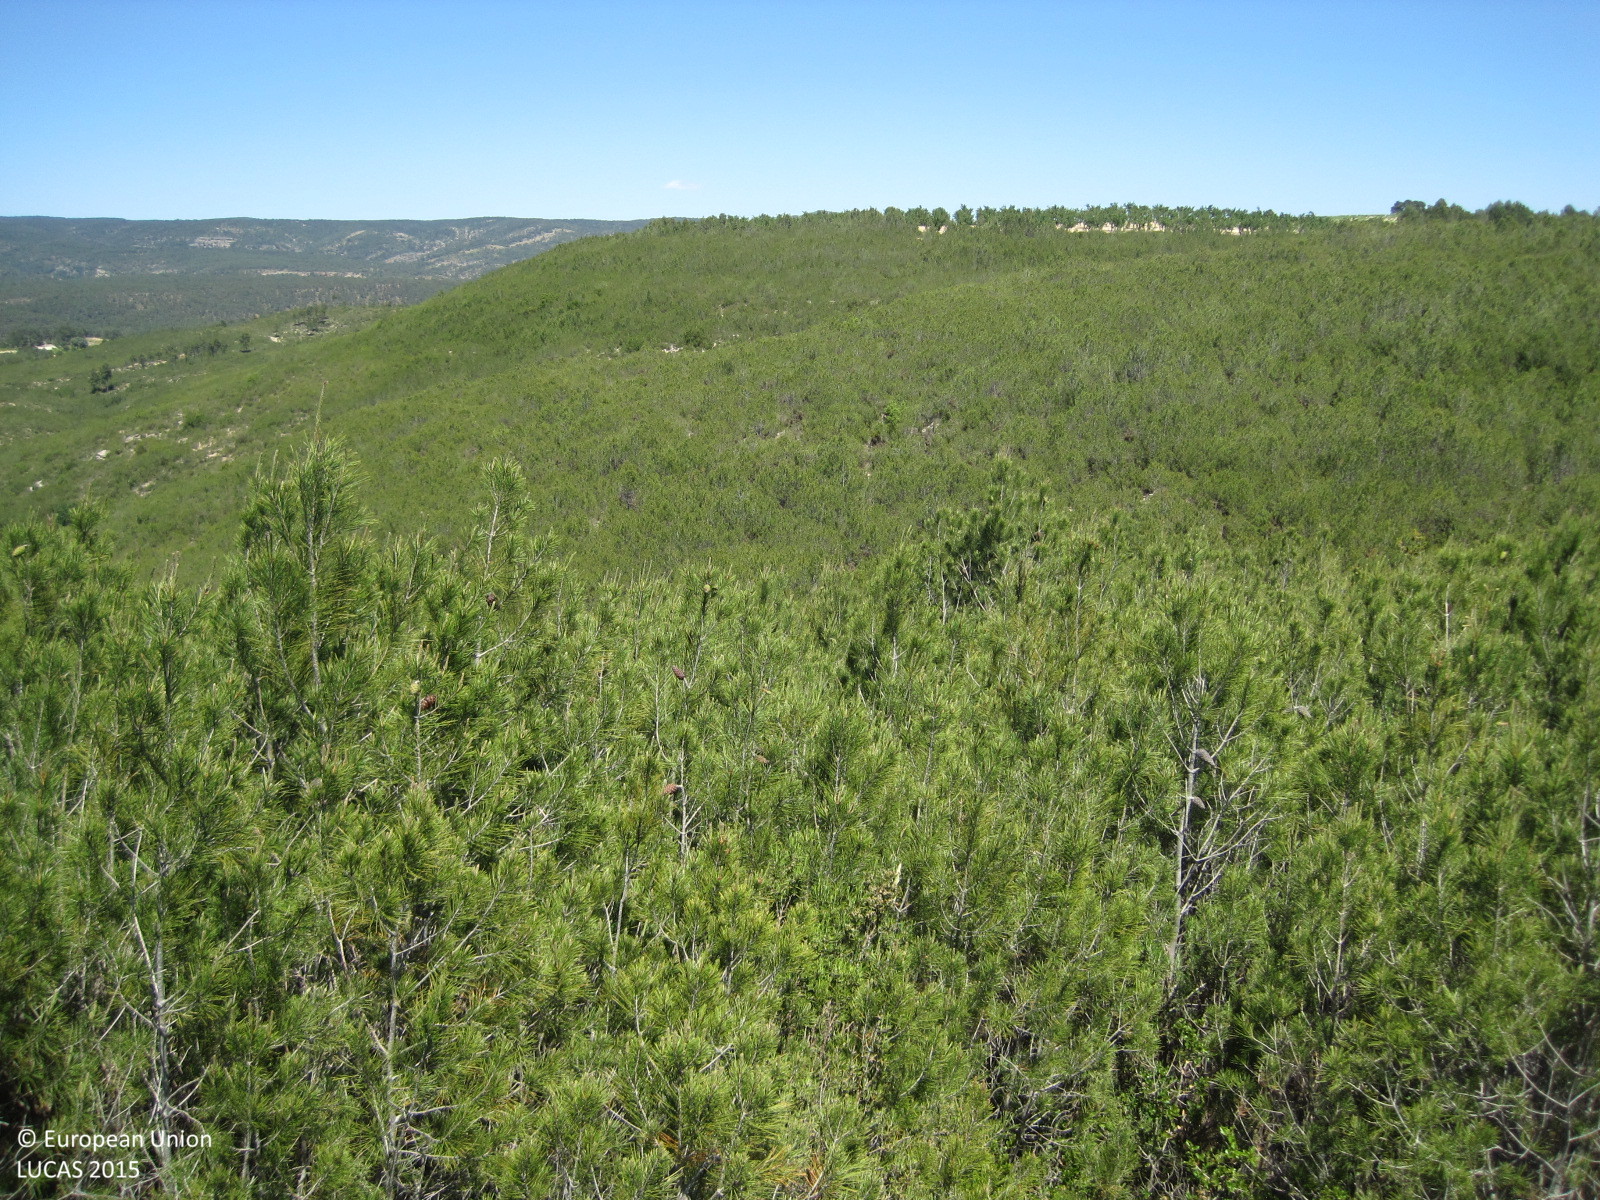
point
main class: Woodland
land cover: Pine dominated coniferous woodland
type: coniferous forest of the mediterranean region
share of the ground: > 75 %
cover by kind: coniferous forest trees 90 %, shrubs 10 %
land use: Forestry
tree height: < 5 m
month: May
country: ES
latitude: 39.3814
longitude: -1.0868
